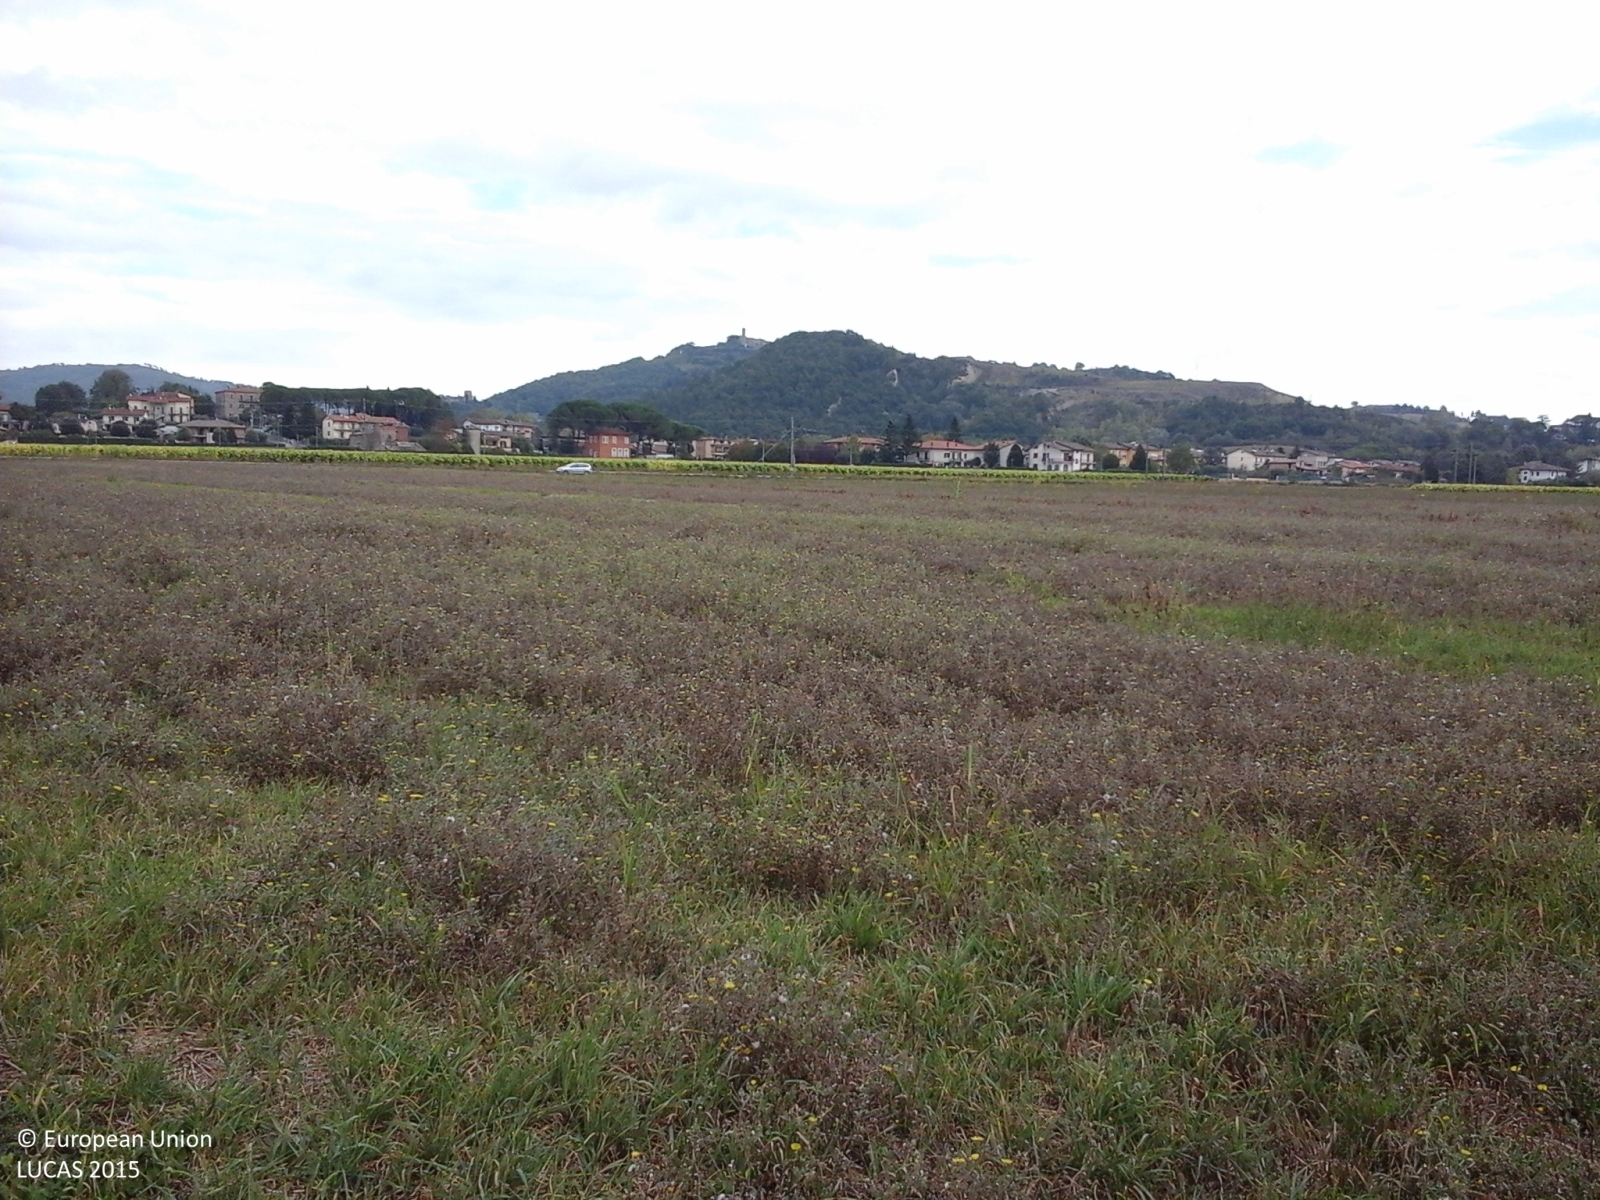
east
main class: Grassland
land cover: Spontaneously vegetated surfaces
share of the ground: 50 - 75 %
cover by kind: herbaceous plants 100 %
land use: Fallow land
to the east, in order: Spontaneously vegetated surfaces; Ditches and canals; Spontaneously vegetated surfaces; Ditches and canals; Common wheat; Tracks; Grass margins; Railways; Grass margins; Tracks; Tobacco
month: October
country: IT
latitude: 43.2032
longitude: 12.4177
